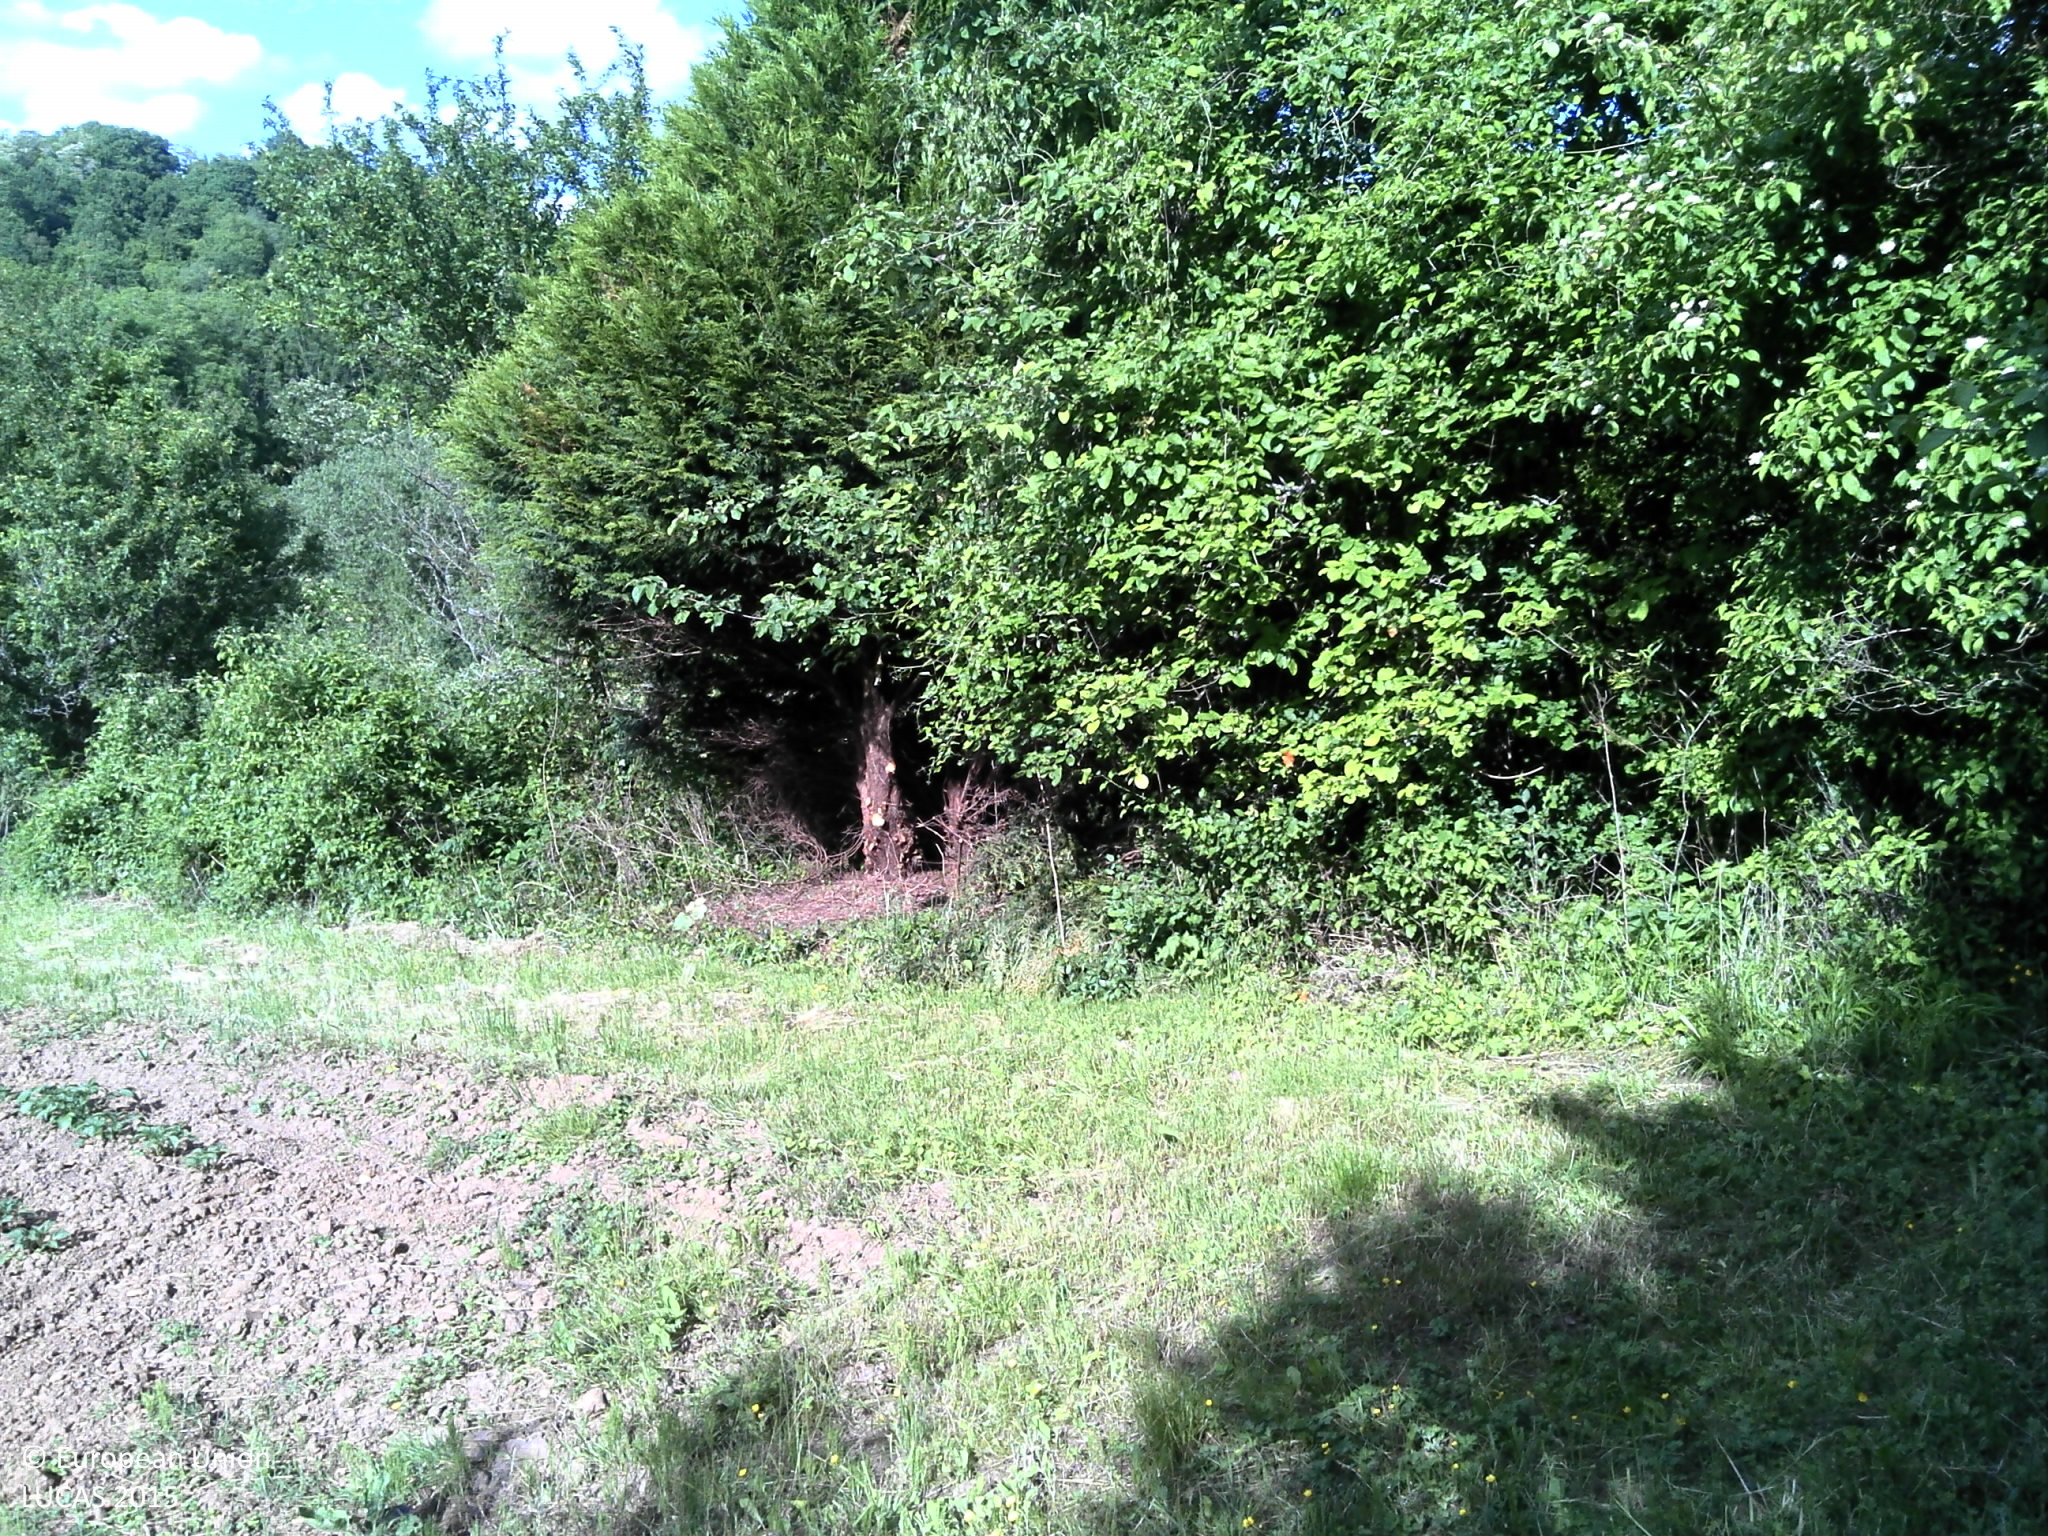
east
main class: Grassland
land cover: Grassland without tree/shrub cover
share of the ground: > 75 %
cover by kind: herbaceous plants 100 %
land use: Agriculture (excluding fallow land and kitchen gardens)
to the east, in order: Grassland without tree/shrub cover; Broadleaved woodland; Grass margins; Potatoes; Fences; Potatoes; Fences; Apple fruit; Grassland without tree/shrub cover; Shruby margins; Broadleaved woodland; Spontaneously vegetated surfaces; Lines of trees; Grassland without tree/shrub cover; Broadleaved woodland; Grassland without tree/shrub cover; Broadleaved woodland; Grassland without tree/shrub cover; Paved roads, cycling and walking lanes; Grassland without tree/shrub cover
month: June
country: FR
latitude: 49.0363
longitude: 6.0738
